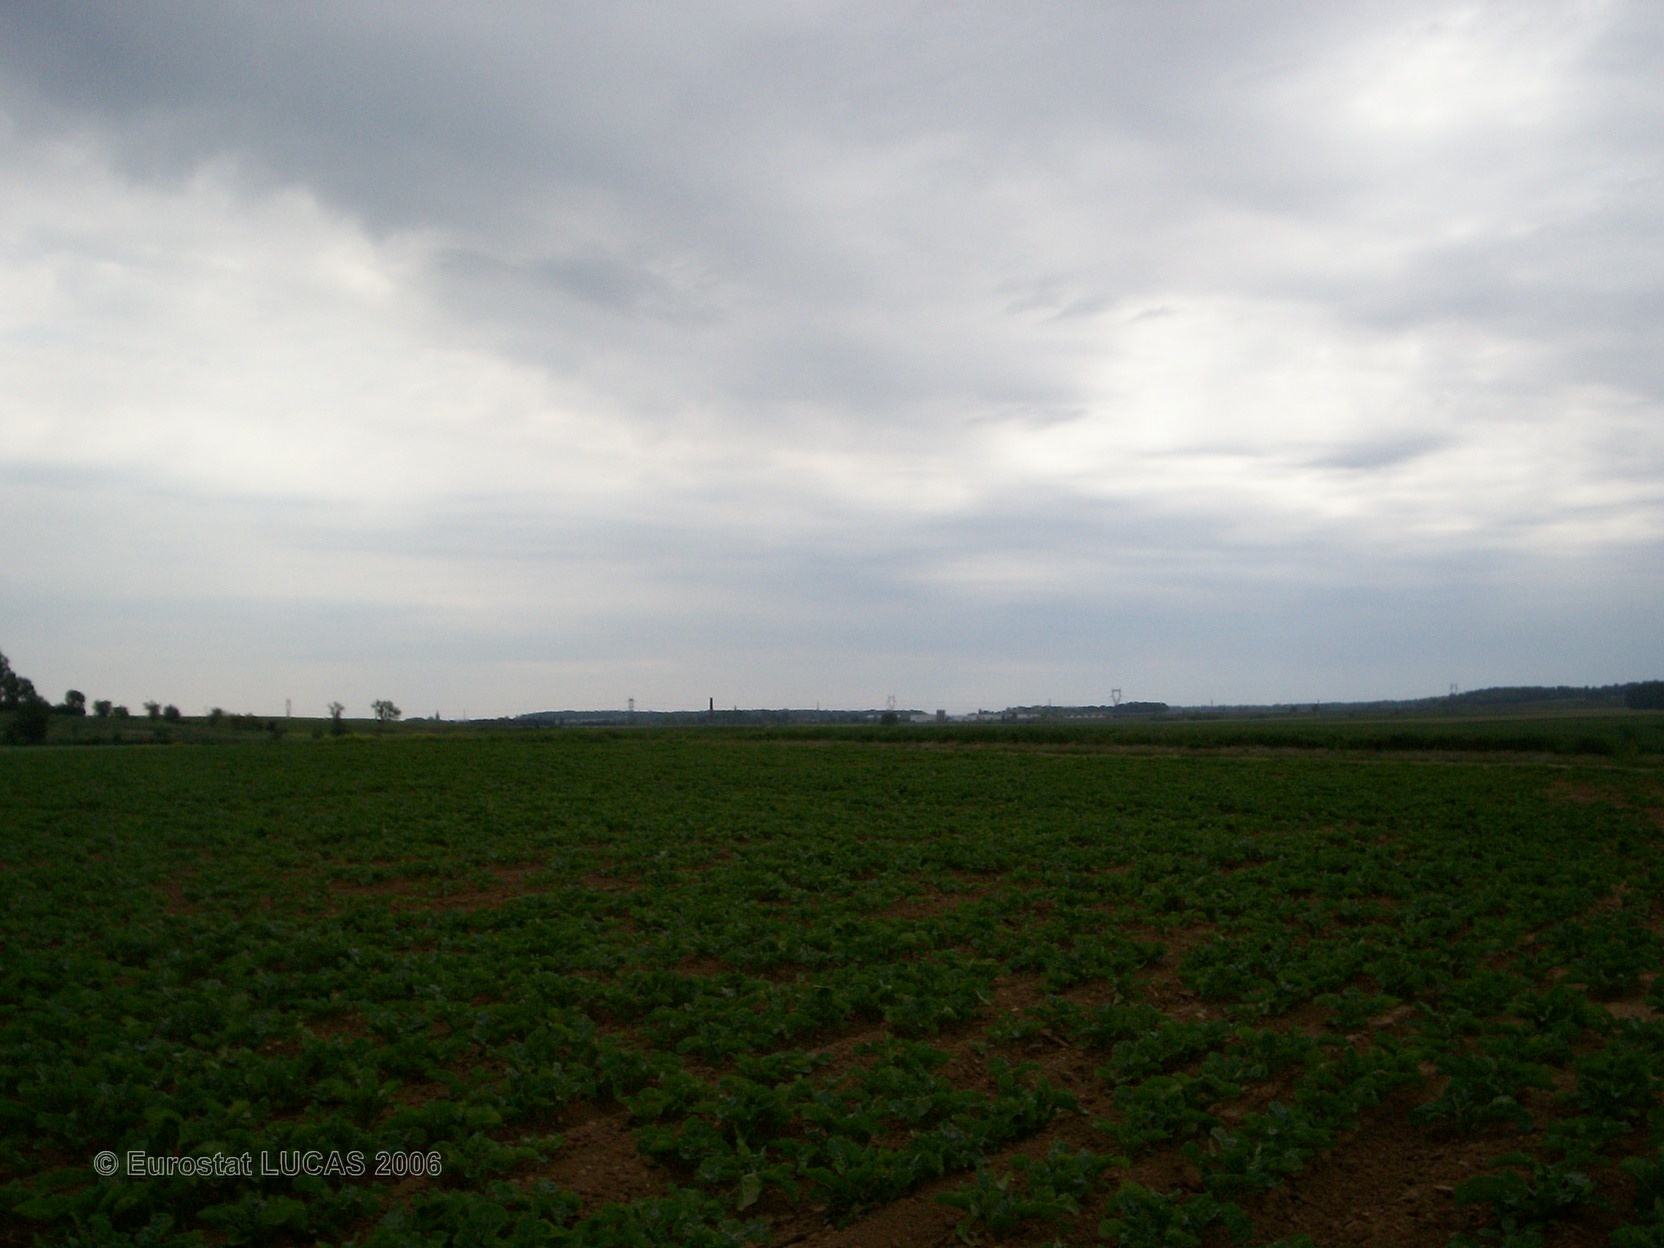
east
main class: Cropland
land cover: Sugar beet
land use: Agriculture (excluding fallow land and kitchen gardens)
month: June
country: FR
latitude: 49.4422
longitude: 2.6655
